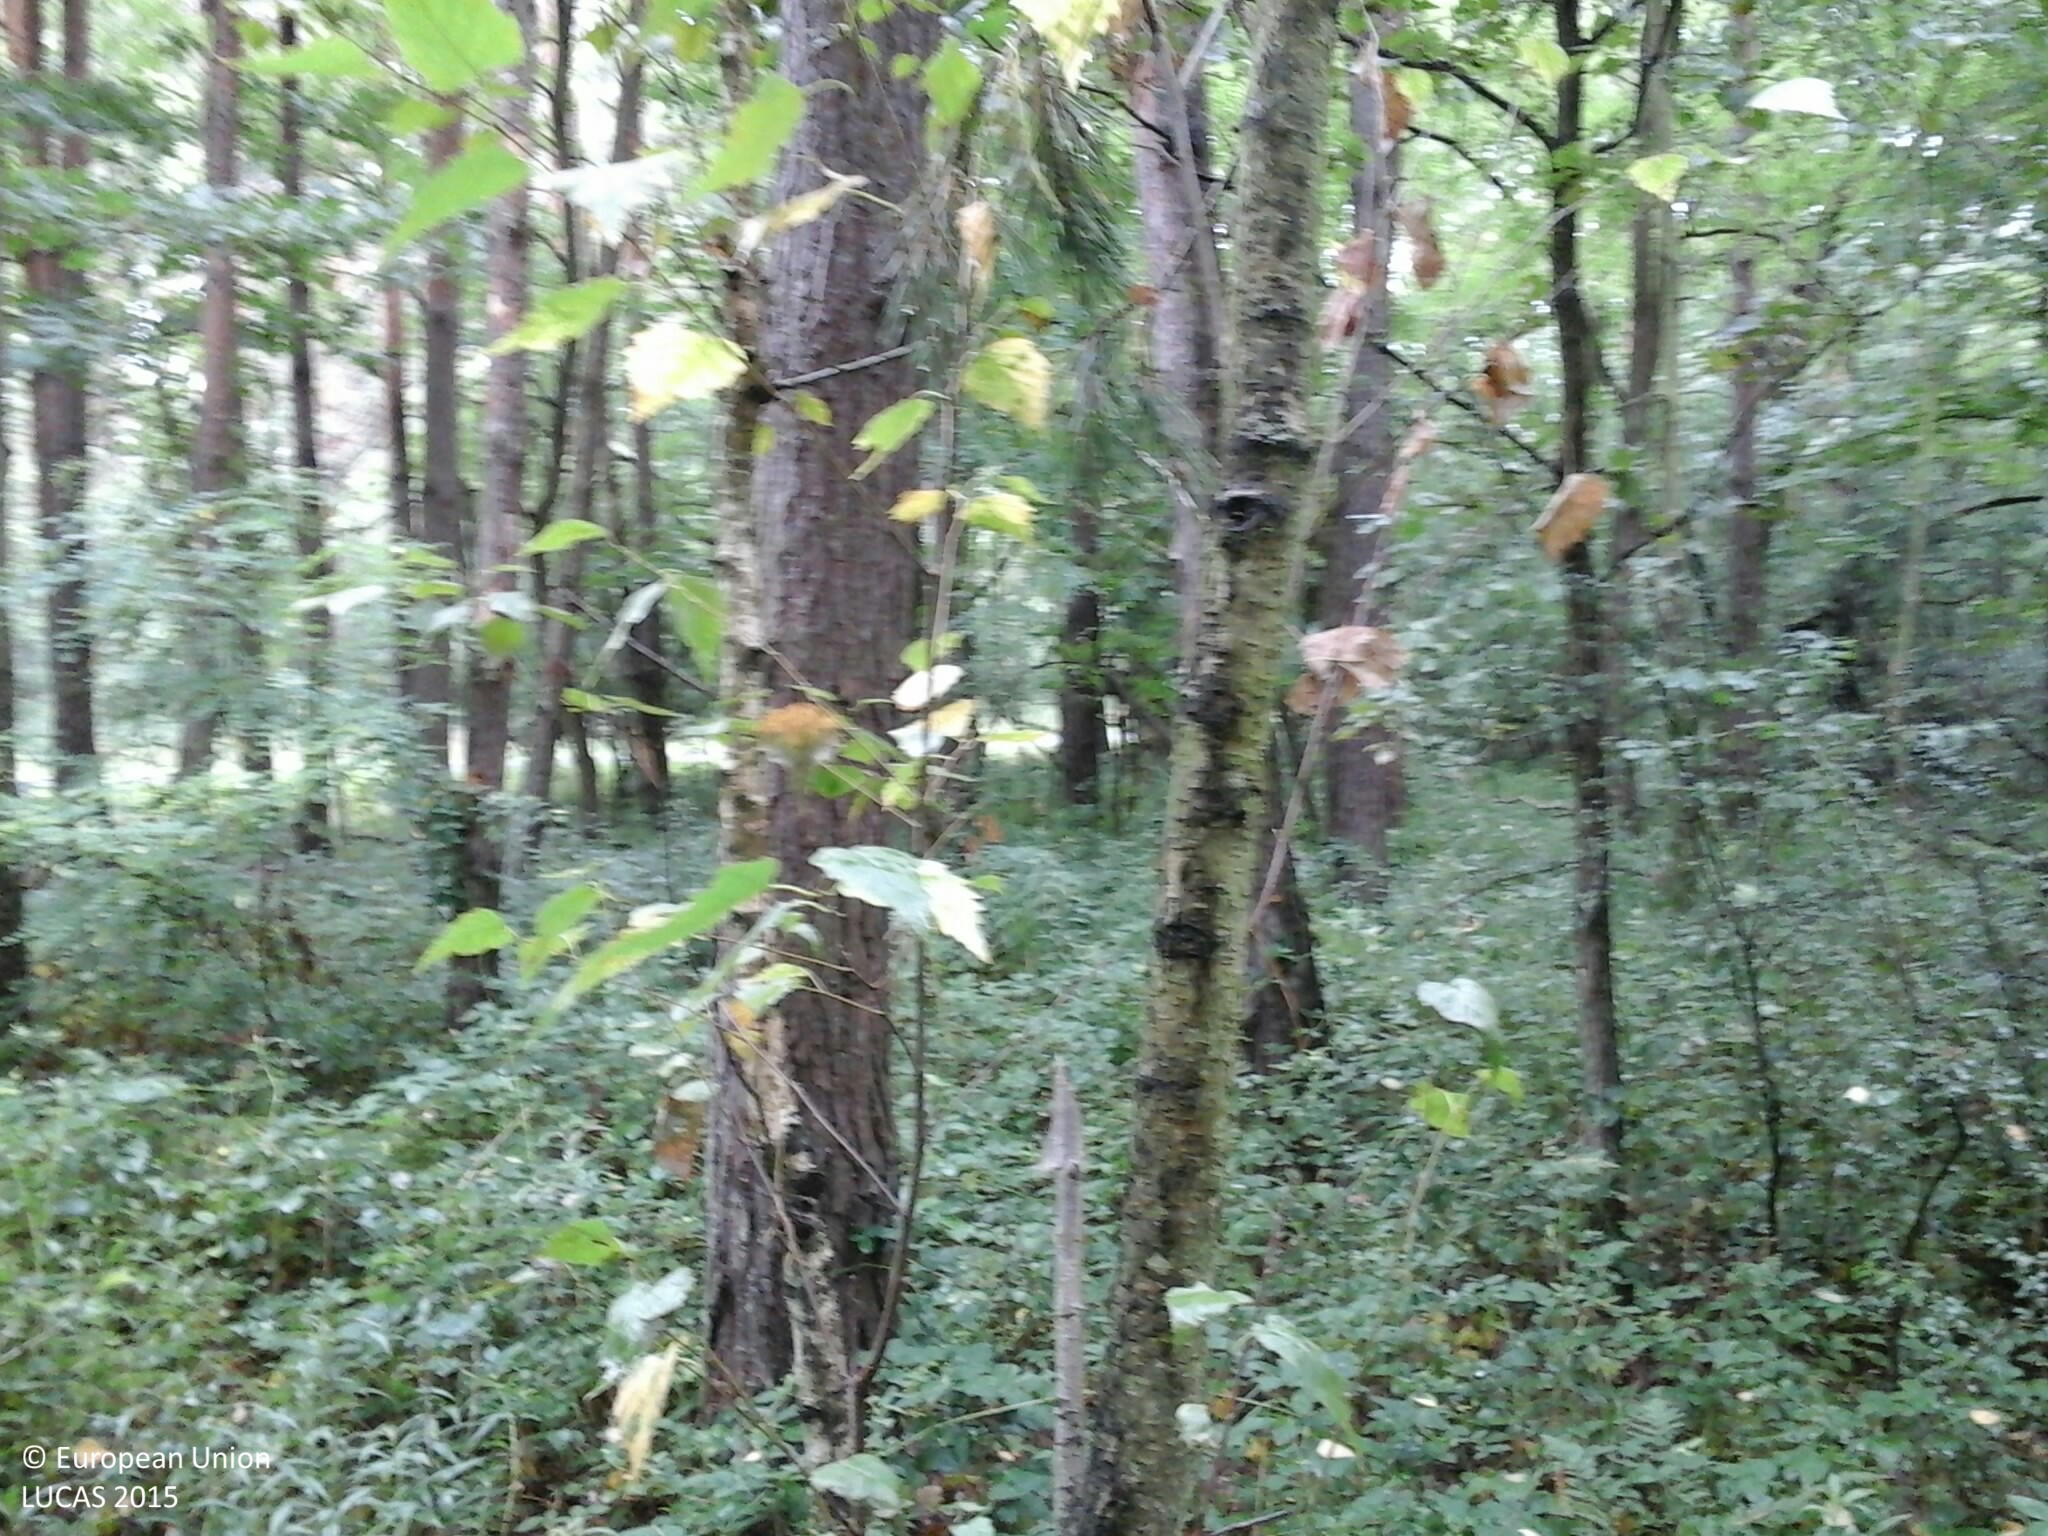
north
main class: Woodland
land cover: Pine dominated mixed woodland
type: hemiboreal forest and nemoral coniferous forest and mixed broadleaved-coniferous forest
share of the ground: > 75 %
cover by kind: coniferous forest trees 40 %, broadleaved forest trees 30 %, shrubs 20 %, herbaceous plants 10 %
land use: Forestry
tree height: > 5 m
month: July
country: HU
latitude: 46.9089
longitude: 16.5538
